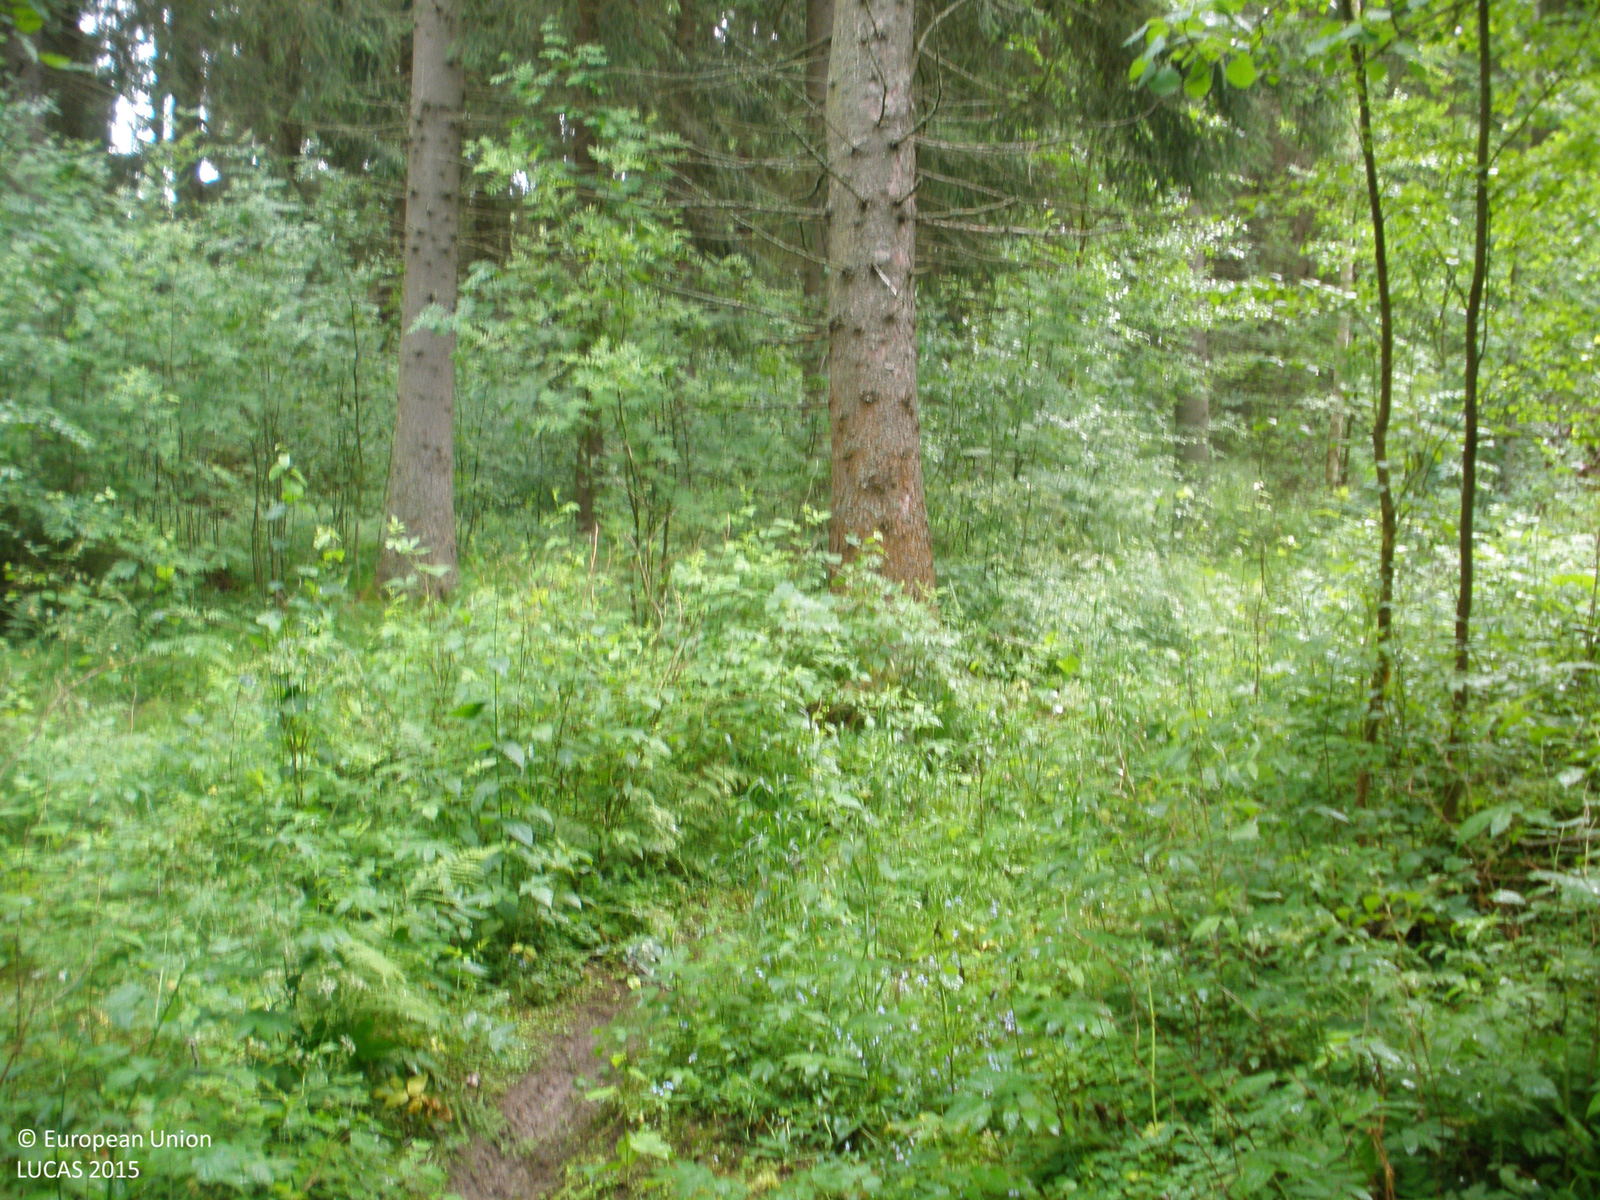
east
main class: Woodland
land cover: Broadleaved woodland
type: boreal forest
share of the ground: > 75 %
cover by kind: broadleaved forest trees 80 %, shrubs 10 %, coniferous forest trees 5 %, herbaceous plants 5 %
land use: Forestry
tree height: > 5 m
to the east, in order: Broadleaved woodland; Spruce dominated coniferous woodland; Tracks; Spruce dominated coniferous woodland; Tracks; Spruce dominated coniferous woodland; Broadleaved woodland; Ditches and canals; Grass margins; Barley; Grass margins; Ditches and canals; Broadleaved woodland; Ditches and canals; Broadleaved woodland; Inland marshes
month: July
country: FI
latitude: 61.4343
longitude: 24.0568
